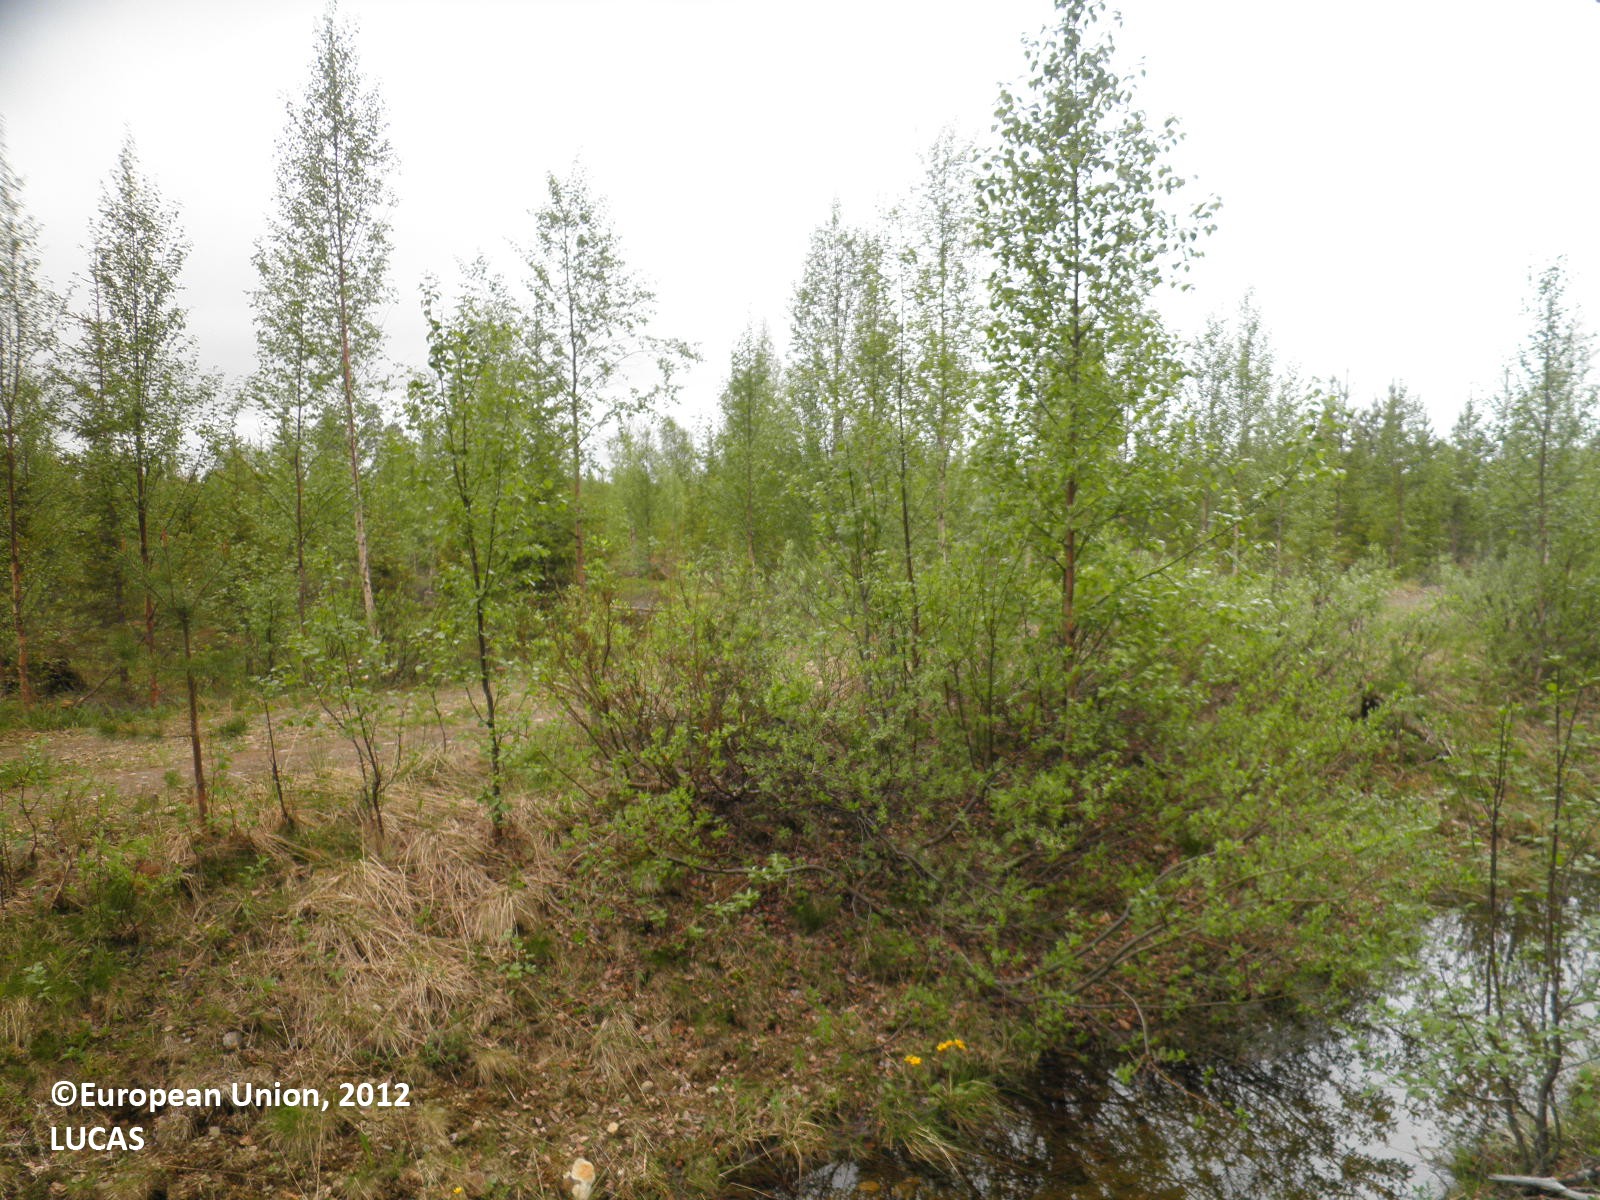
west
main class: Woodland
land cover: Spruce dominated mixed woodland
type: boreal forest
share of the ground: 25 - 50 %
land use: Forestry
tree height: > 5 m
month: June
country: FI
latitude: 67.8191
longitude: 25.6897
